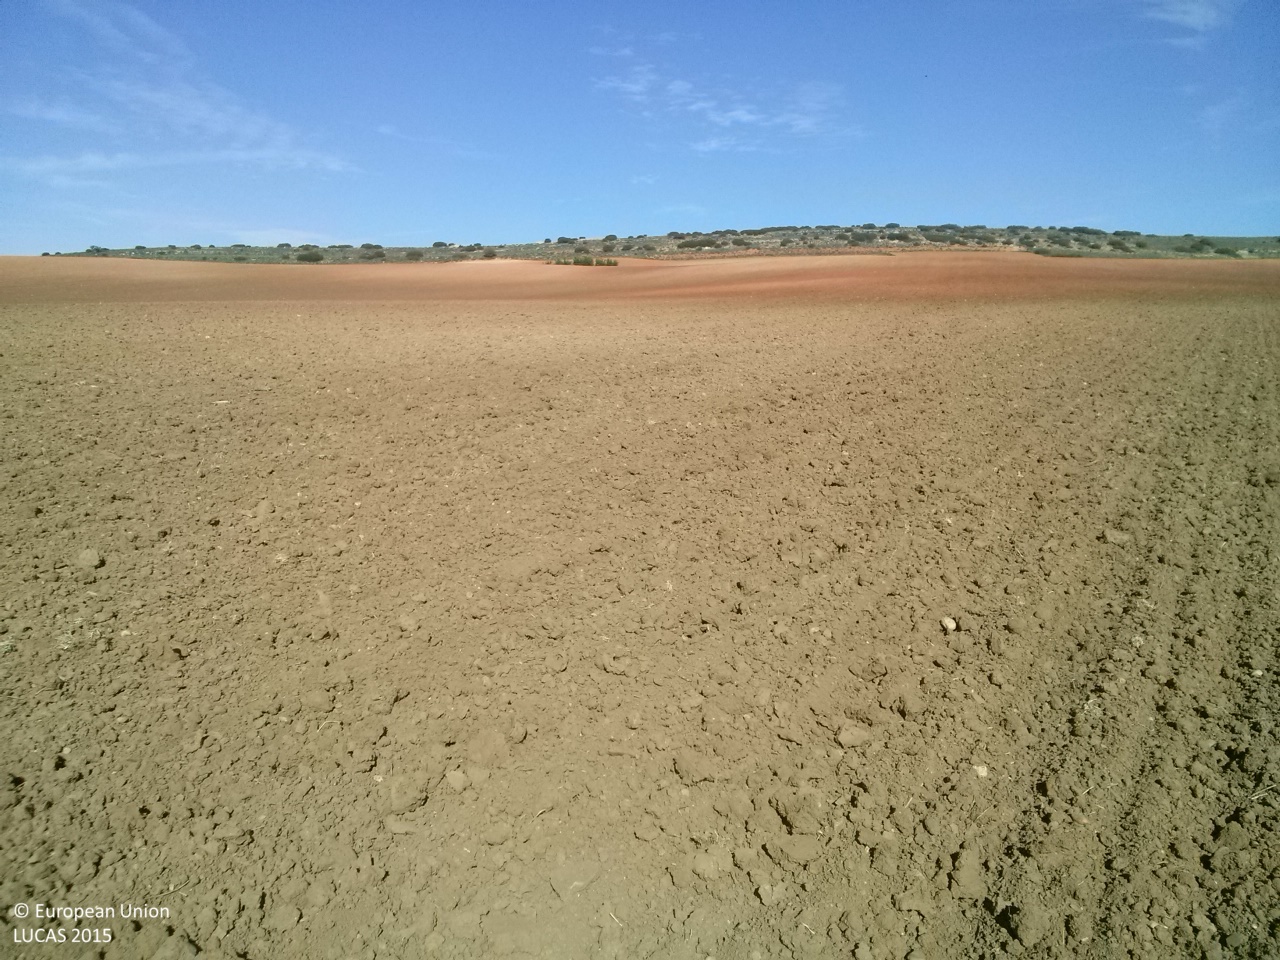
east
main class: Cropland
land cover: Sunflower
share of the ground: < 10 %
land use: Agriculture (excluding fallow land and kitchen gardens)
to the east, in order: Sunflower; Grass margins
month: May
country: ES
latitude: 39.8528
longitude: -2.7475
